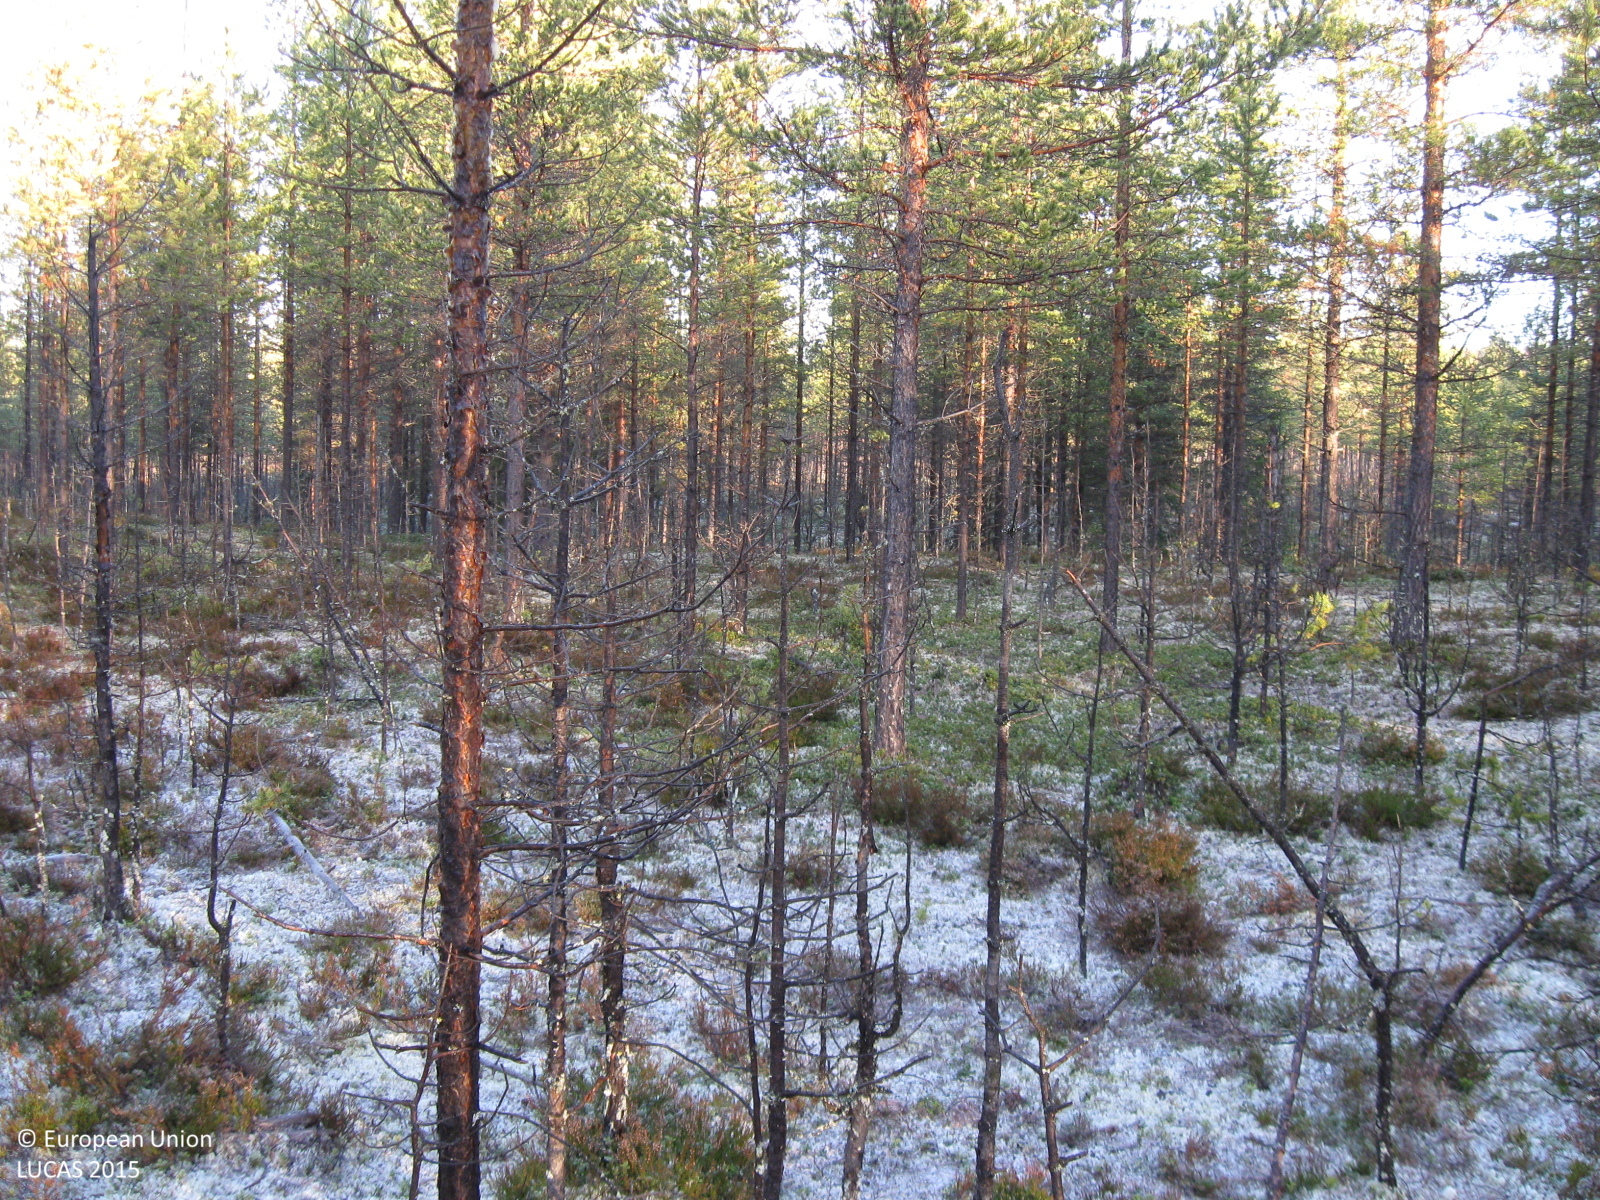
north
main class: Woodland
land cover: Pine dominated coniferous woodland
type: boreal forest
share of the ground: 50 - 75 %
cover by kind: coniferous forest trees 55 %, lichens and mosses 30 %, shrubs 10 %, herbaceous plants 5 %
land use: Forestry
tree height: > 5 m
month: October
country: SE
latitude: 66.2738
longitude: 20.8518
